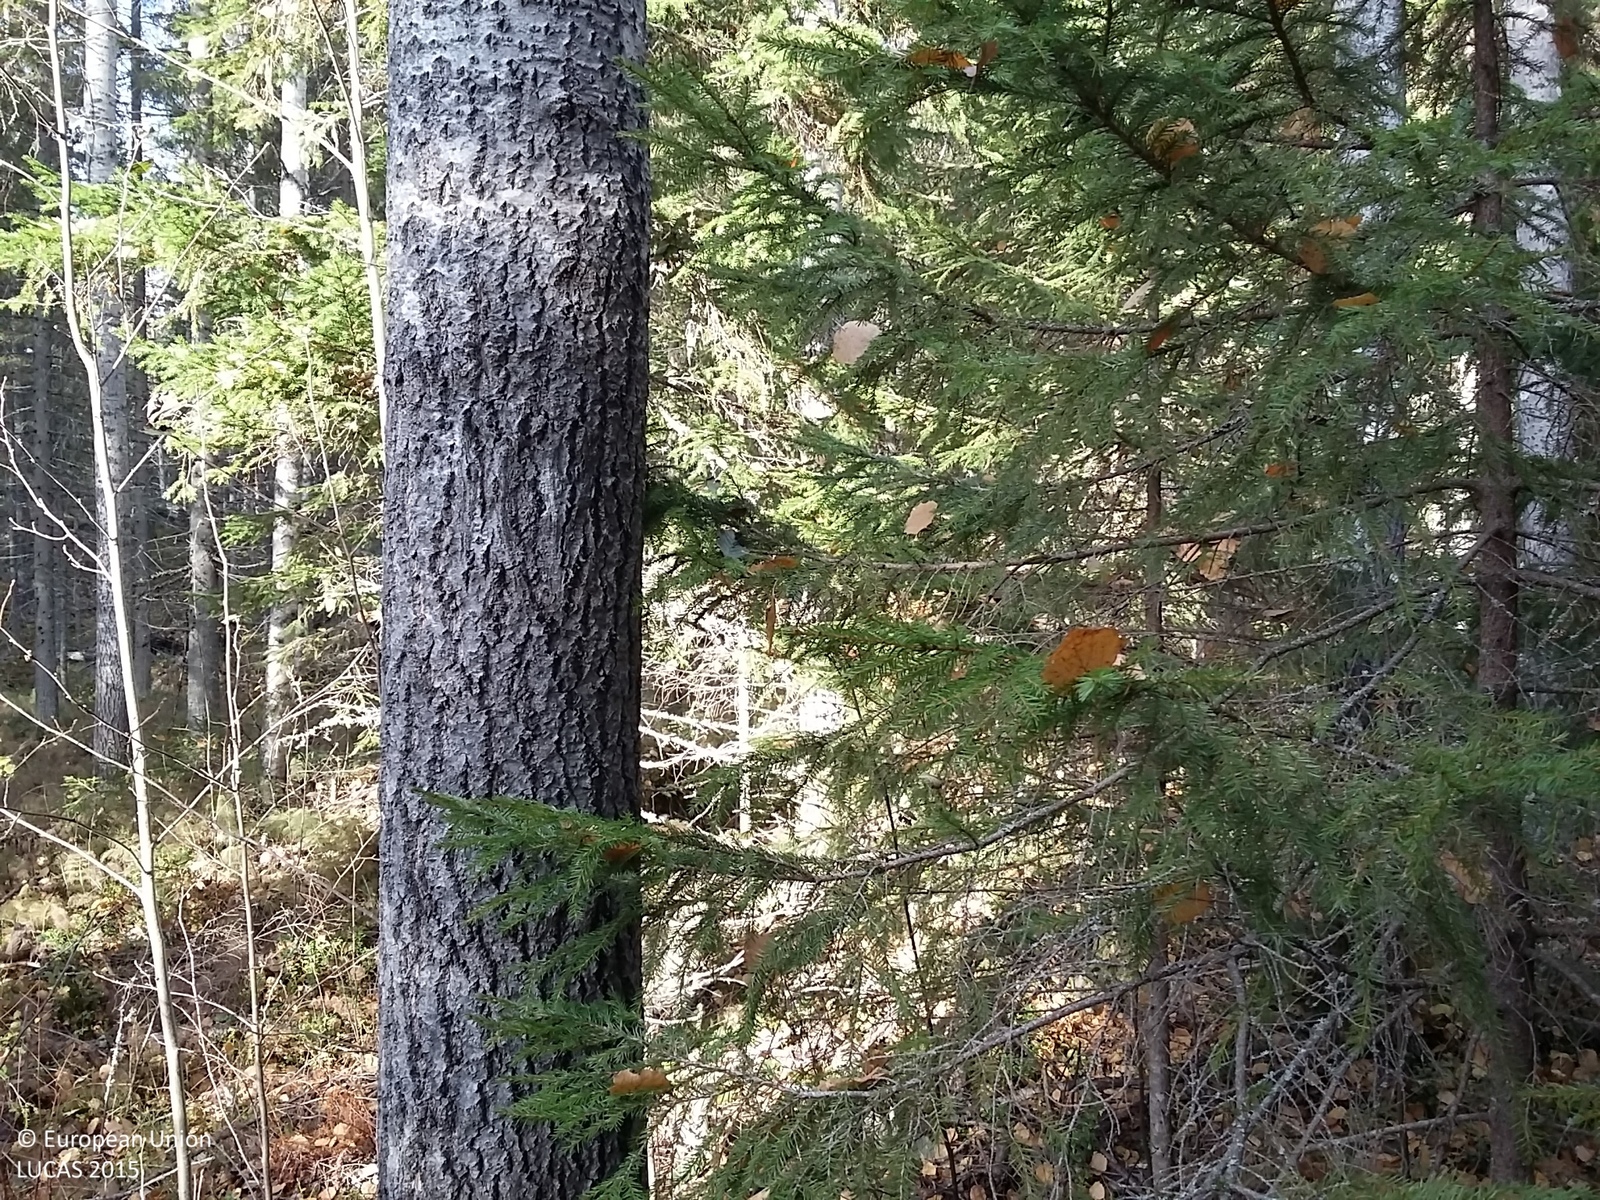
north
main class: Woodland
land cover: Spruce dominated mixed woodland
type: boreal forest
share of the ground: > 75 %
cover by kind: coniferous forest trees 45 %, broadleaved forest trees 40 %, herbaceous plants 10 %, lichens and mosses 5 %
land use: Forestry
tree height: > 5 m
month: October
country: FI
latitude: 62.7987
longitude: 26.0245
